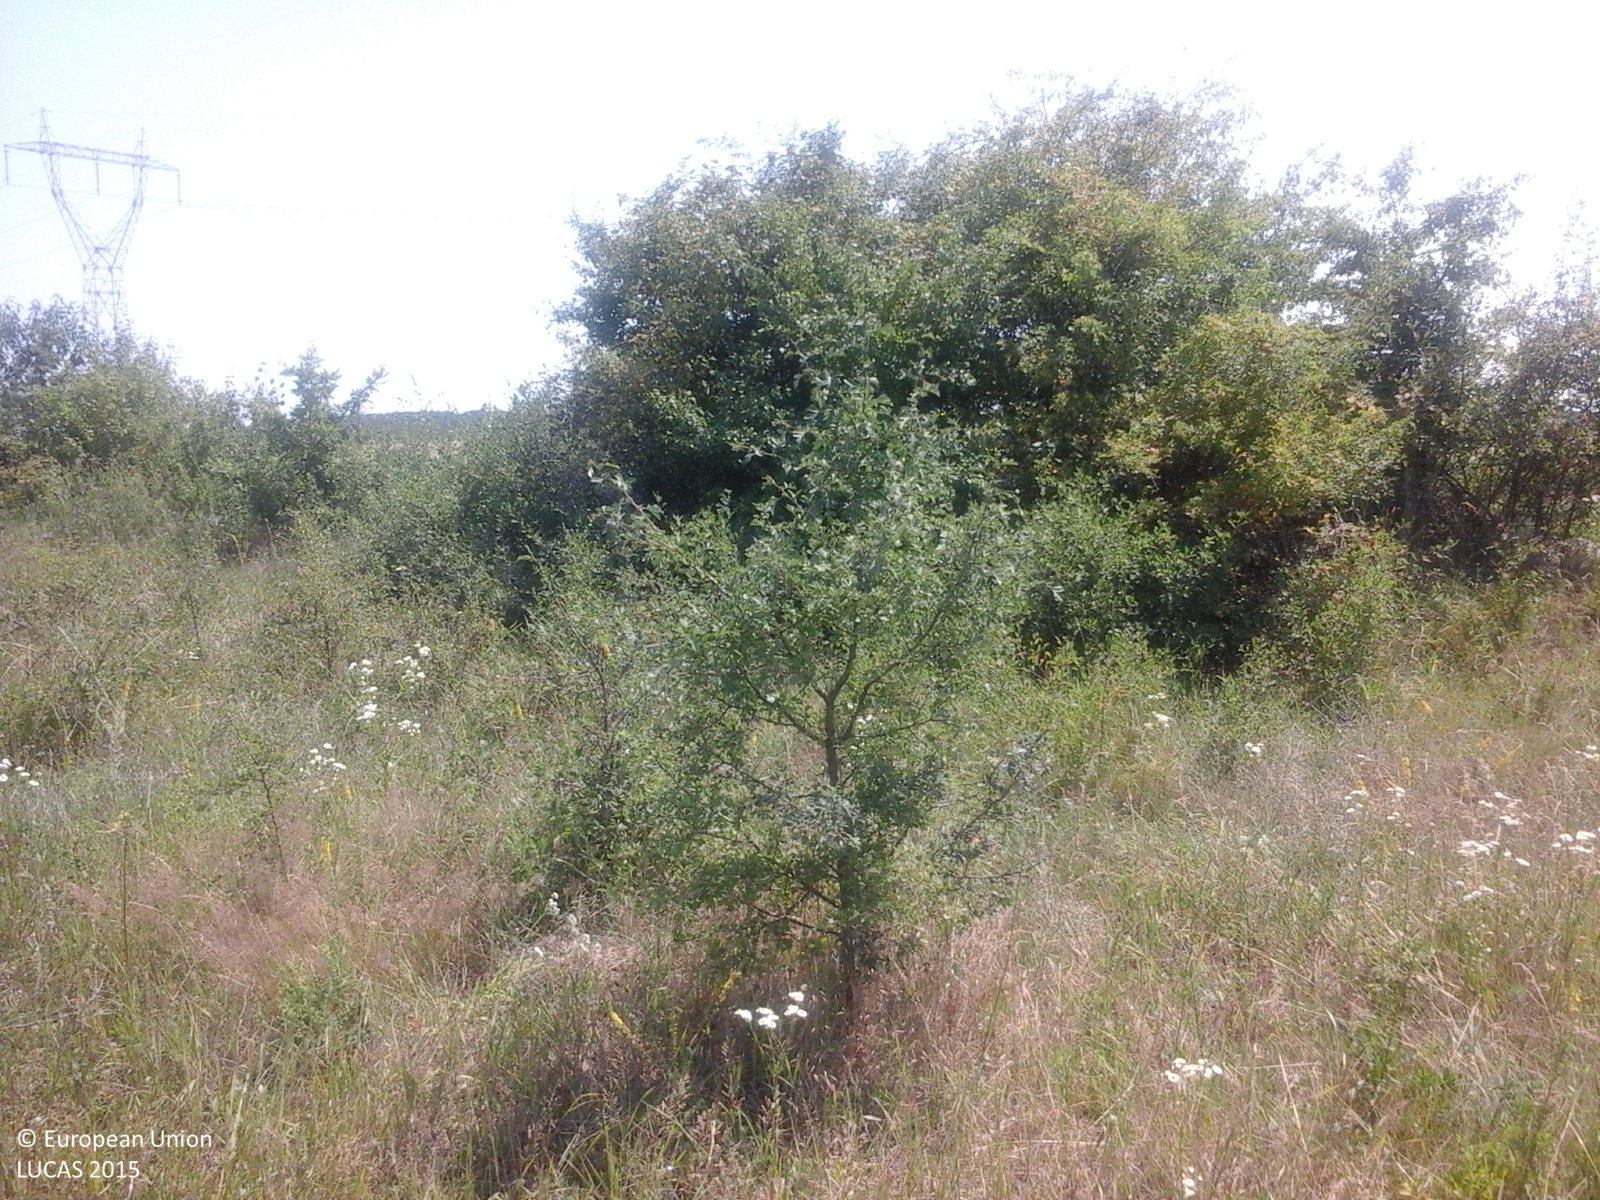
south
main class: Grassland
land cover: Grassland with sparse tree/shrub cover
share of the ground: > 75 %
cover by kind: herbaceous plants 95 %, broadleaved forest trees 5 %
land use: Agriculture (excluding fallow land and kitchen gardens)
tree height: < 5 m
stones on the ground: < 10 %
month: July
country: RO
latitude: 44.7657
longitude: 24.7985
